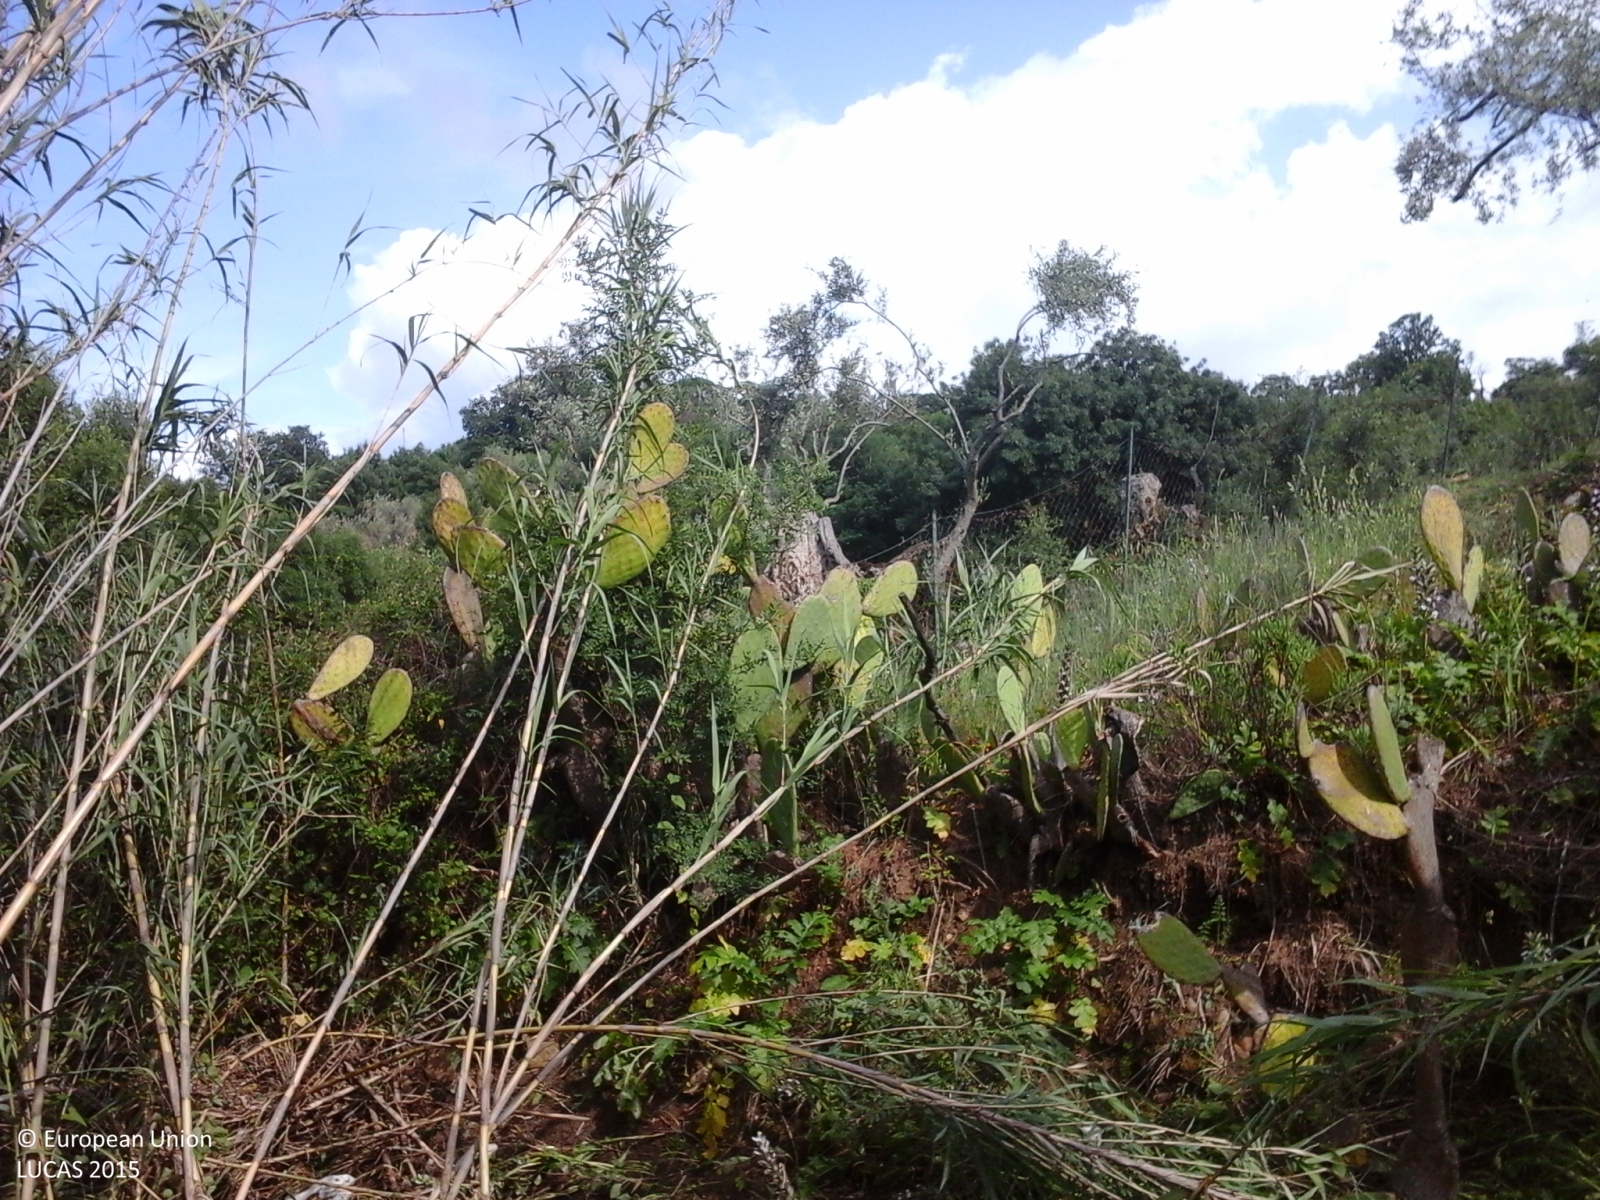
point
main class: Cropland
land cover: Olive groves
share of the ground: 25 - 50 %
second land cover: Spontaneously vegetated surfaces
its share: > 75 %
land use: Agriculture (excluding fallow land and kitchen gardens)
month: May
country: IT
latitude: 37.9316
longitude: 14.1013
